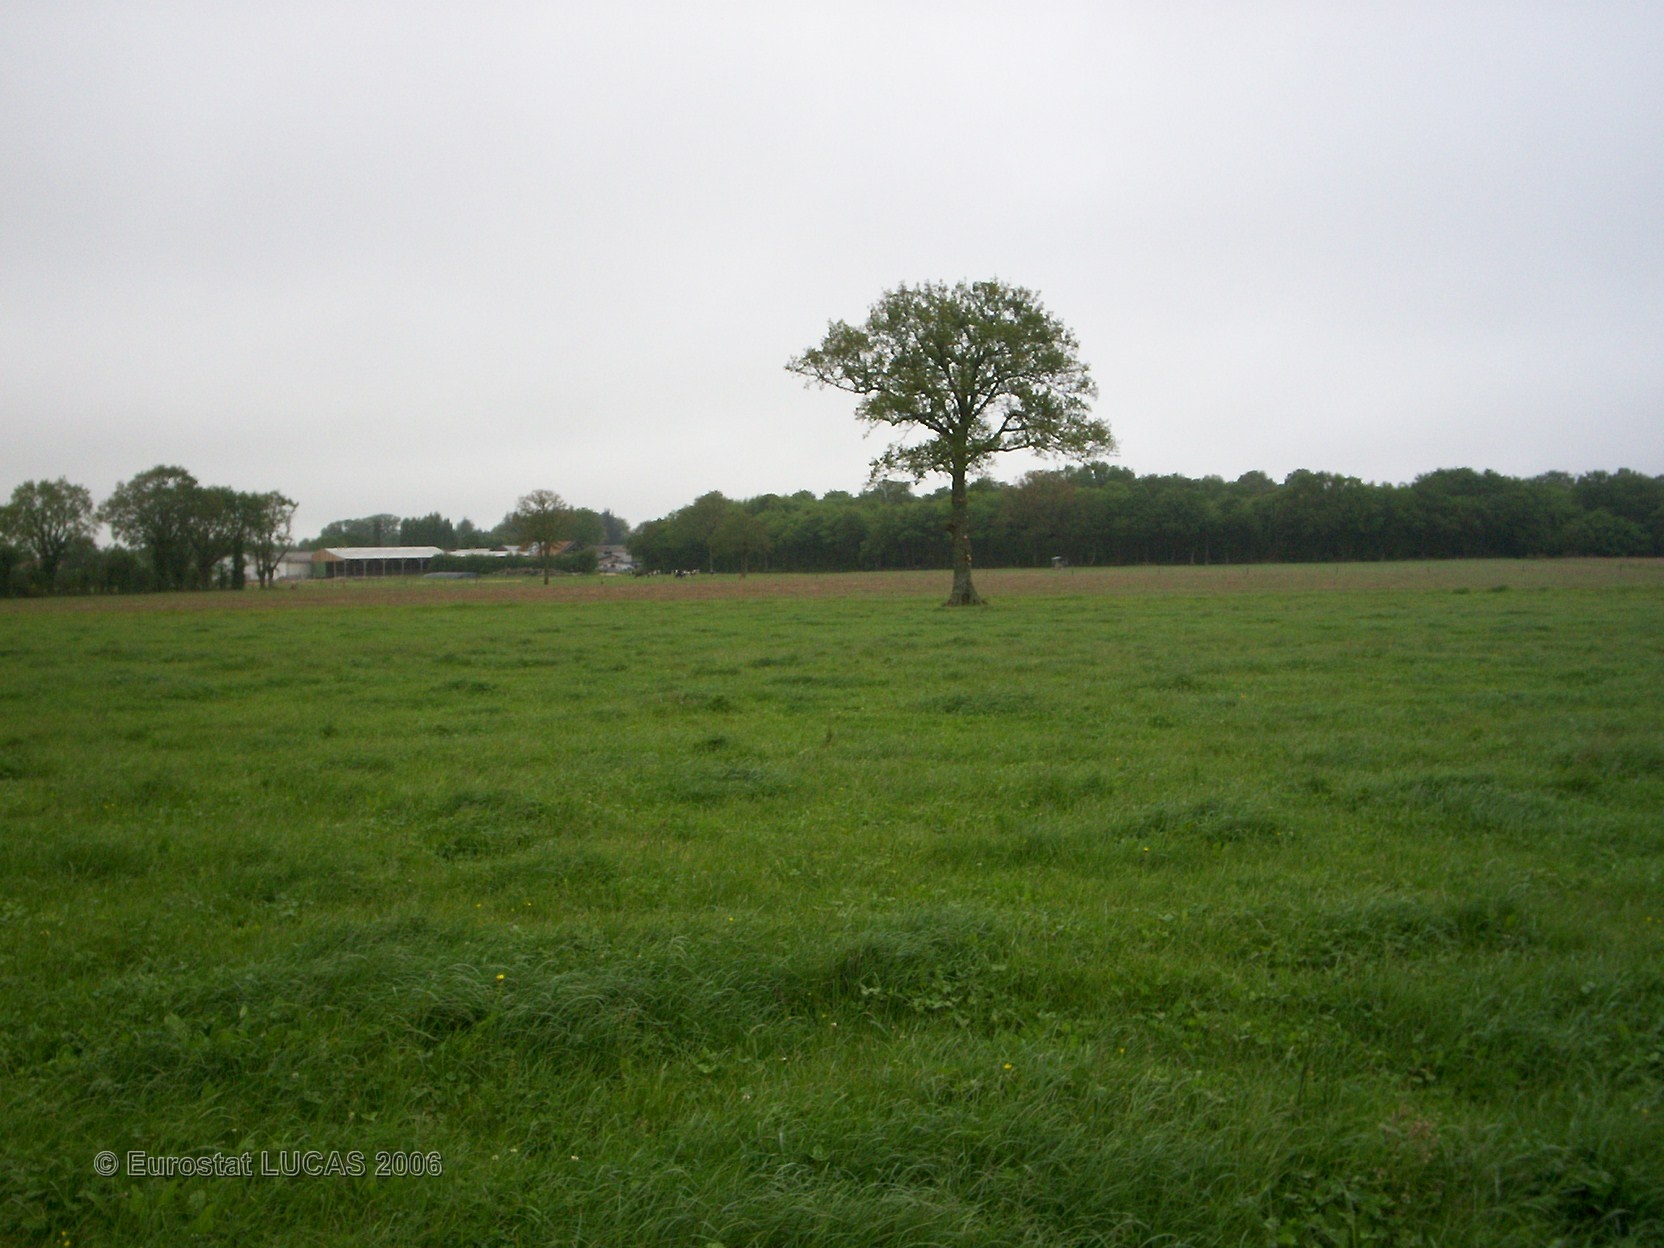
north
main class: Grassland
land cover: Grassland without tree/shrub cover
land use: Agriculture (excluding fallow land and kitchen gardens)
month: May
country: FR
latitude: 47.5486
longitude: -1.4833
